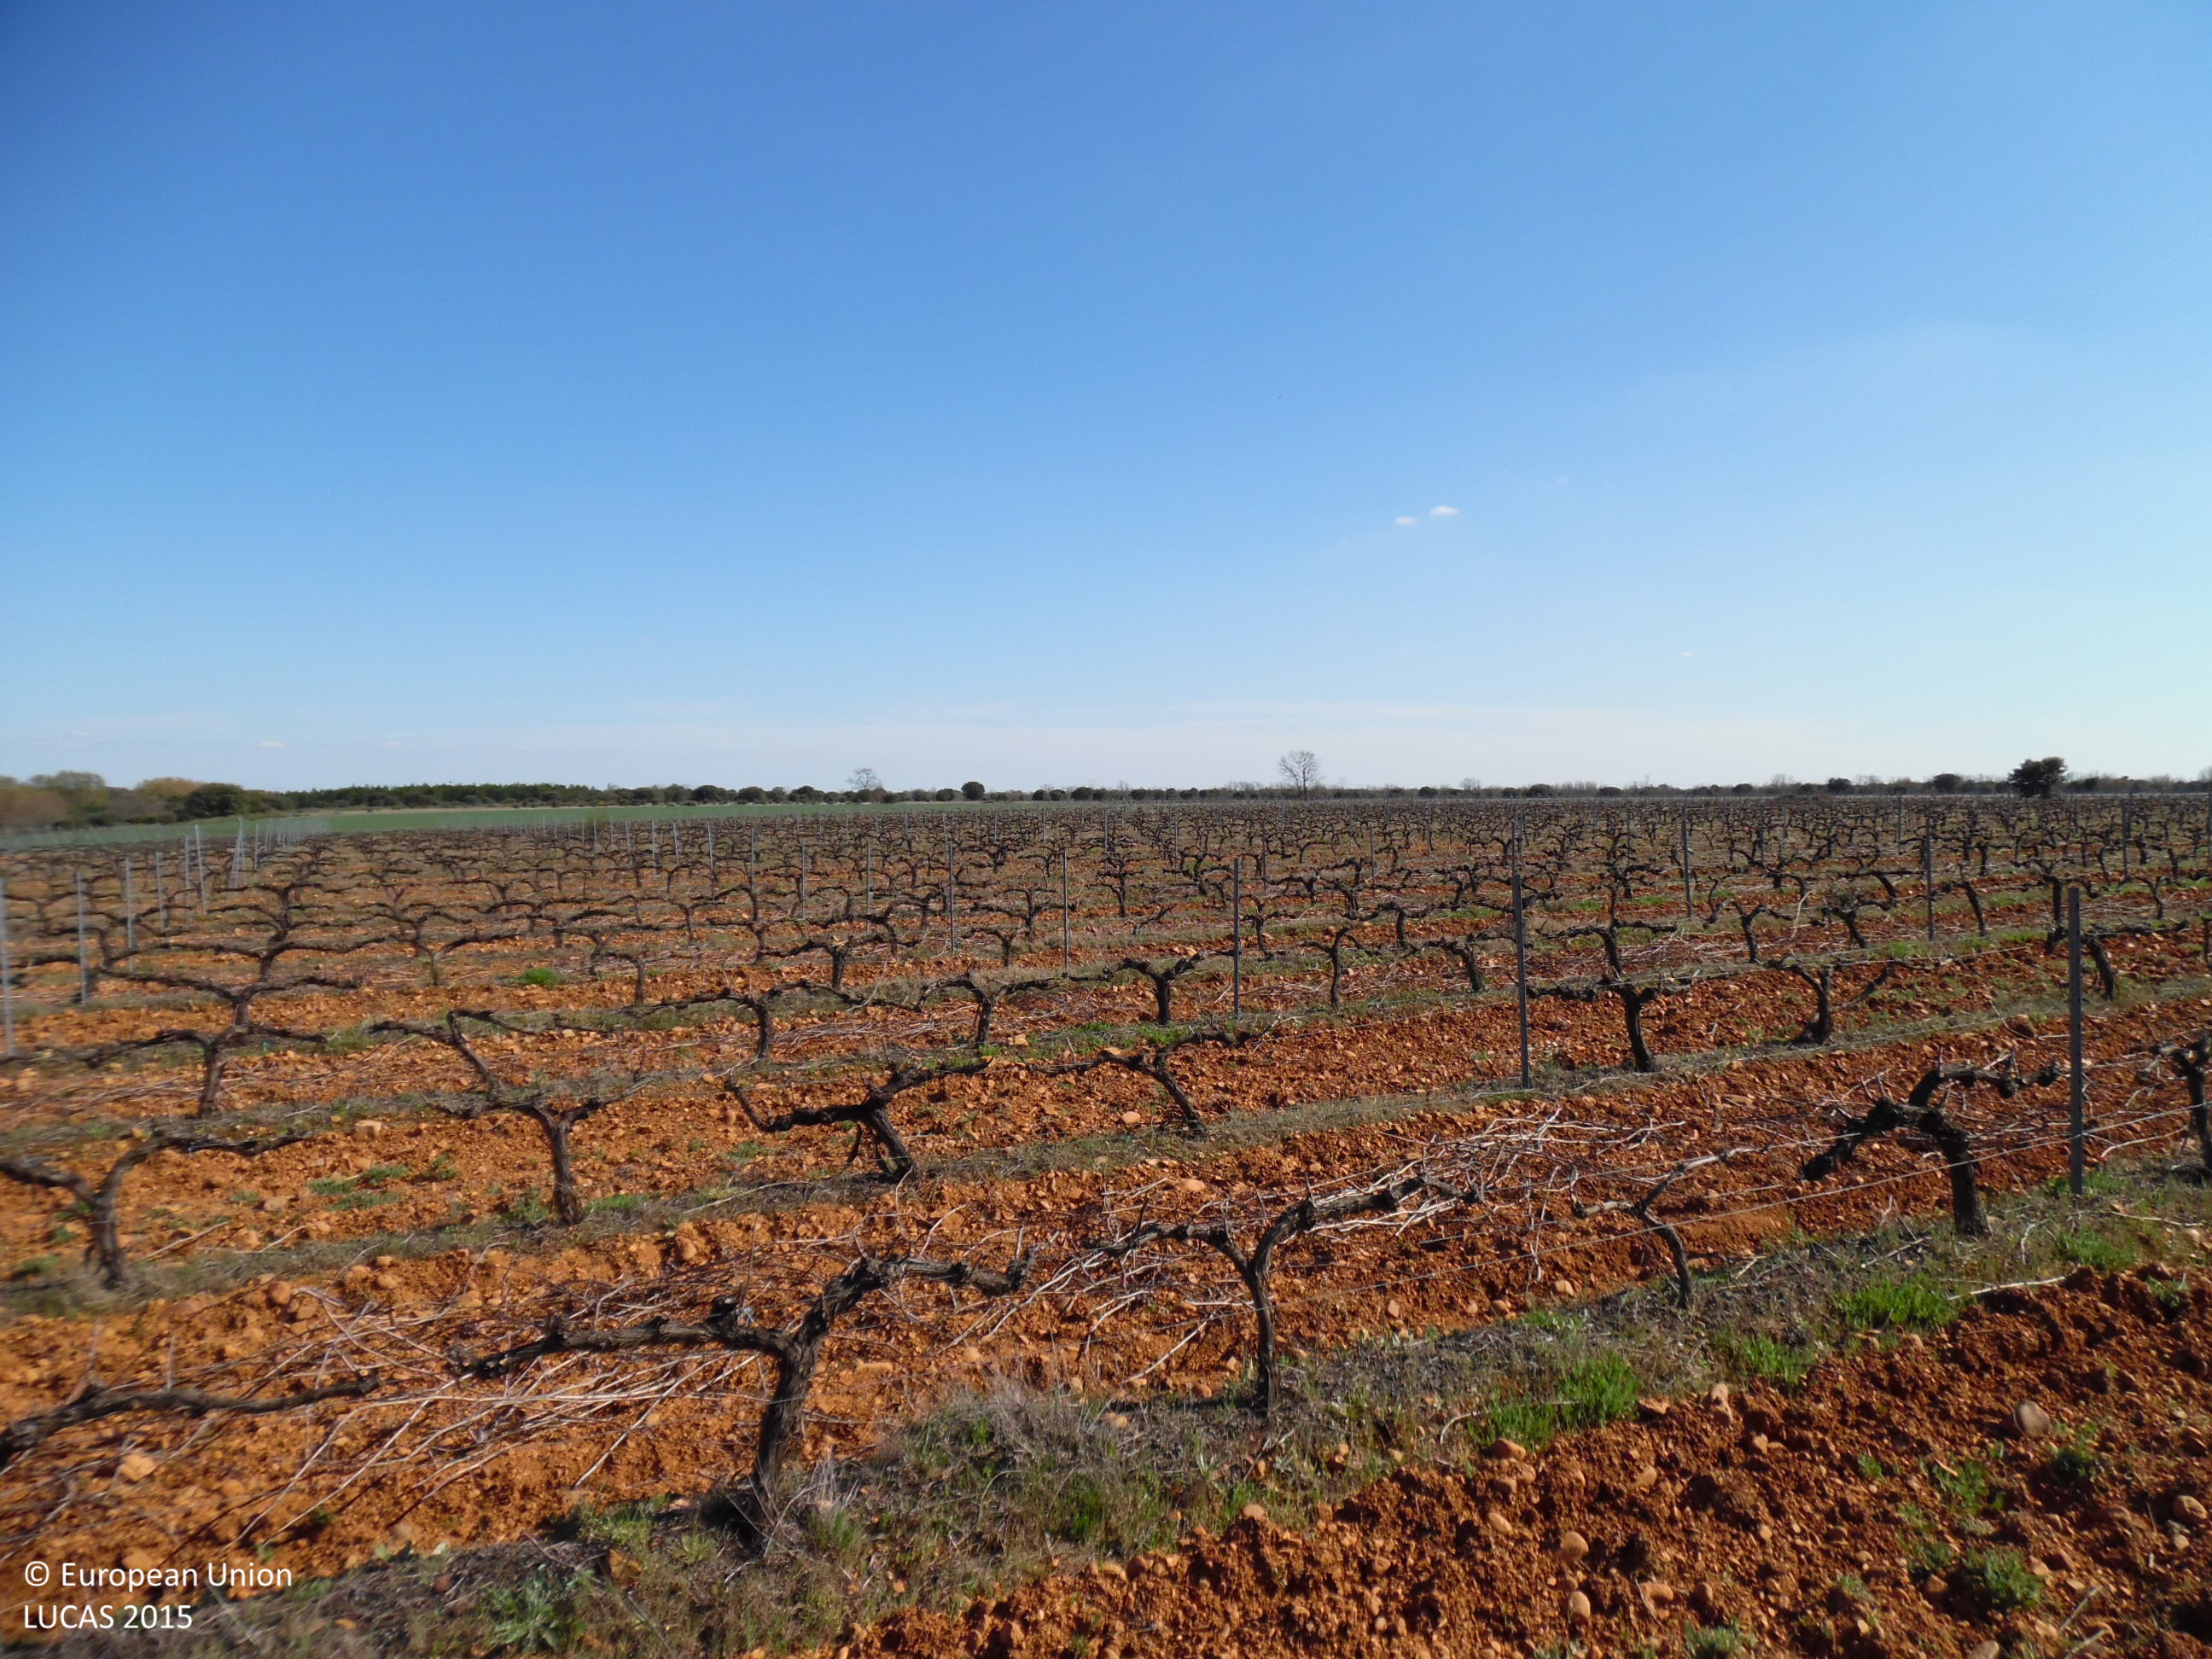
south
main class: Cropland
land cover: Vineyards
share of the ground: < 10 %
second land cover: Other bare soil
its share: > 75 %
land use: Agriculture (excluding fallow land and kitchen gardens)
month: April
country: ES
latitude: 42.4884
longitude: -5.6831
